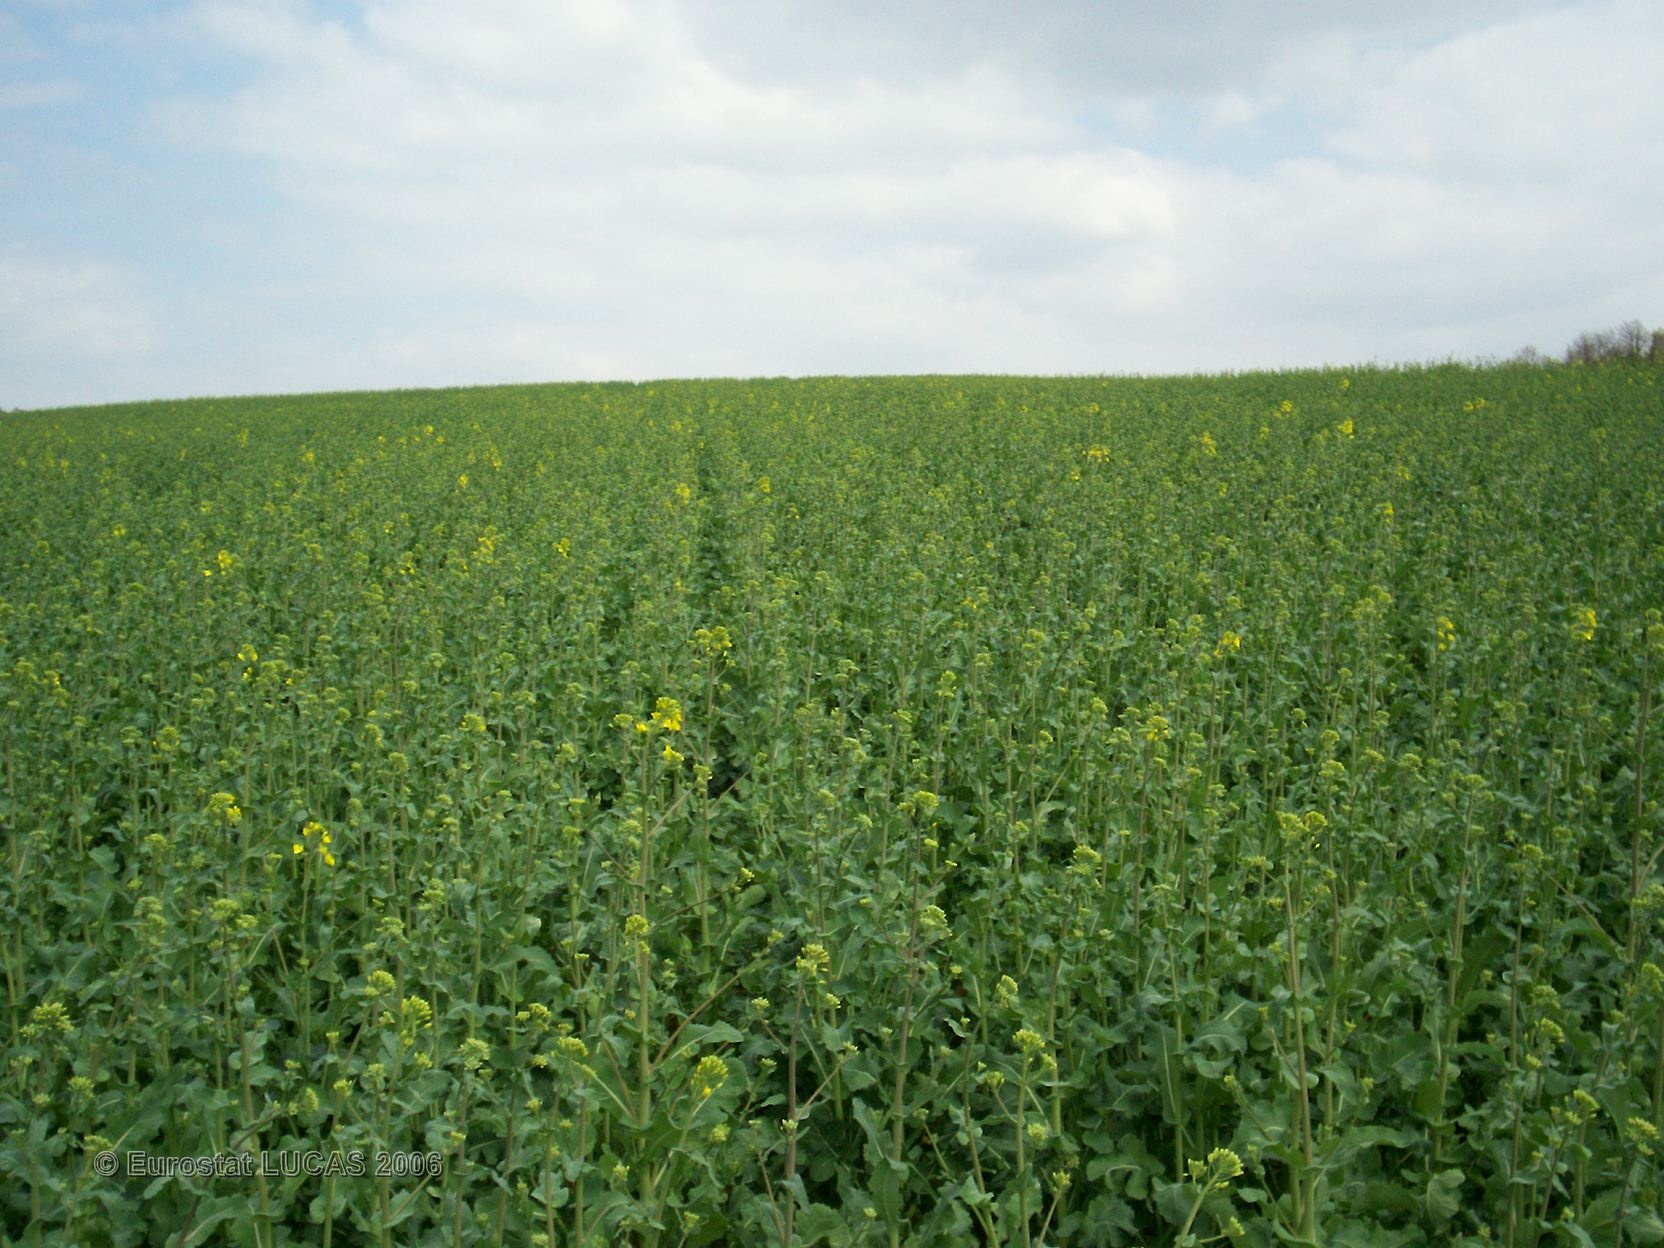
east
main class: Cropland
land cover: Rape and turnip rape
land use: Agriculture (excluding fallow land and kitchen gardens)
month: April
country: FR
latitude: 47.9431
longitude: 4.5226
